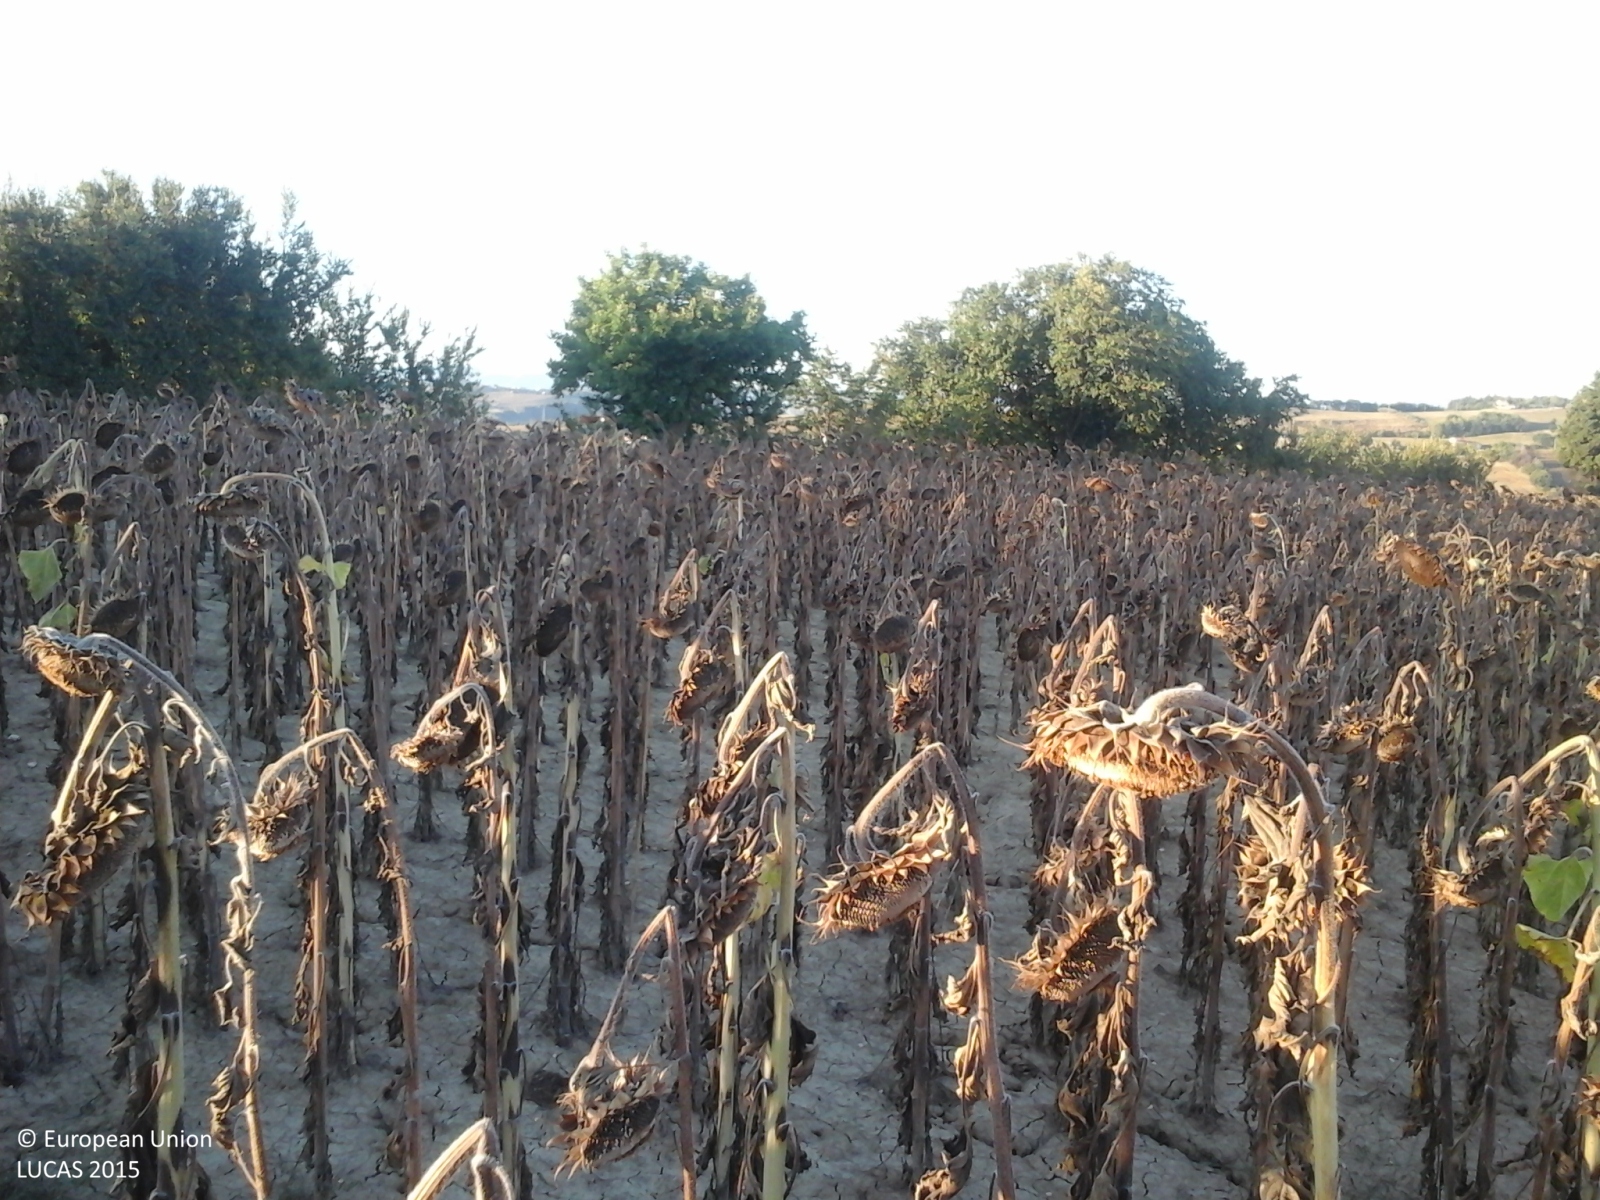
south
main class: Cropland
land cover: Sunflower
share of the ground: > 75 %
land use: Agriculture (excluding fallow land and kitchen gardens)
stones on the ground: < 10 %
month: September
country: IT
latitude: 43.6932
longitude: 13.0077
